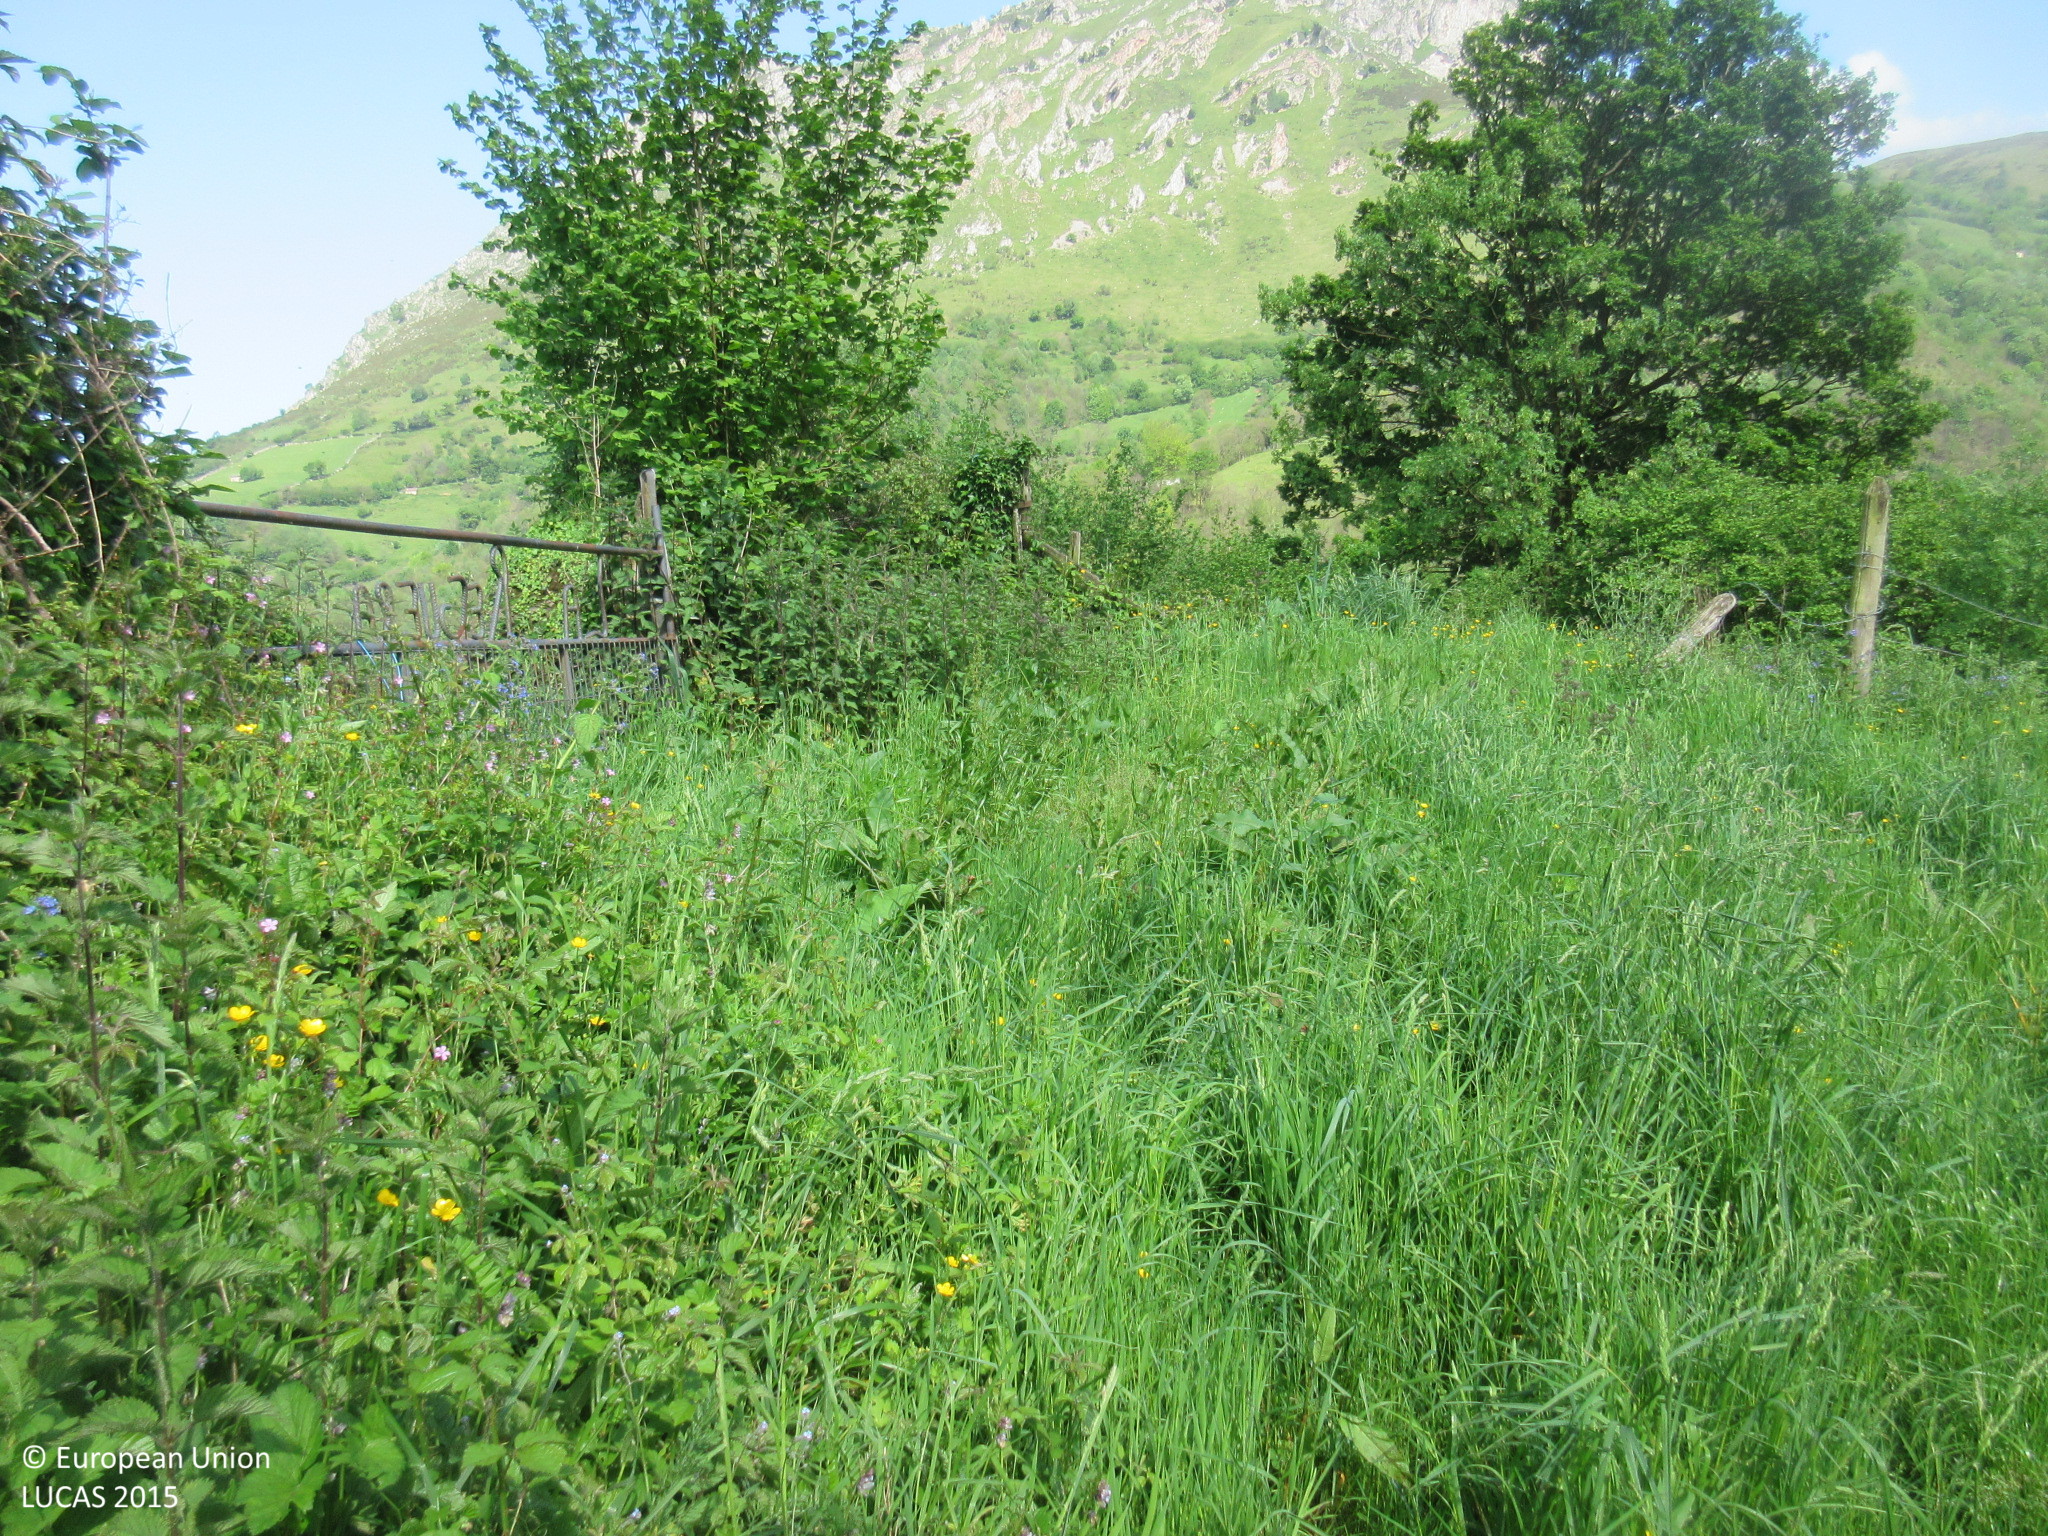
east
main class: Grassland
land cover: Grassland without tree/shrub cover
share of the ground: > 75 %
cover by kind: herbaceous plants 100 %
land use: Agriculture (excluding fallow land and kitchen gardens)
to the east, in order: Grassland without tree/shrub cover; Abandoned hedges; Tracks; Abandoned hedges; Grassland without tree/shrub cover; Abandoned hedges; Grassland without tree/shrub cover; Abandoned hedges; Grassland without tree/shrub cover; Abandoned hedges; Grassland without tree/shrub cover; Abandoned hedges; Tracks; Grassland without tree/shrub cover; Abandoned hedges; Grassland without tree/shrub cover; Single bushes/trees; Rivers and streams; Grassland without tree/shrub cover
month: May
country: ES
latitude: 43.2593
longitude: -5.9175
